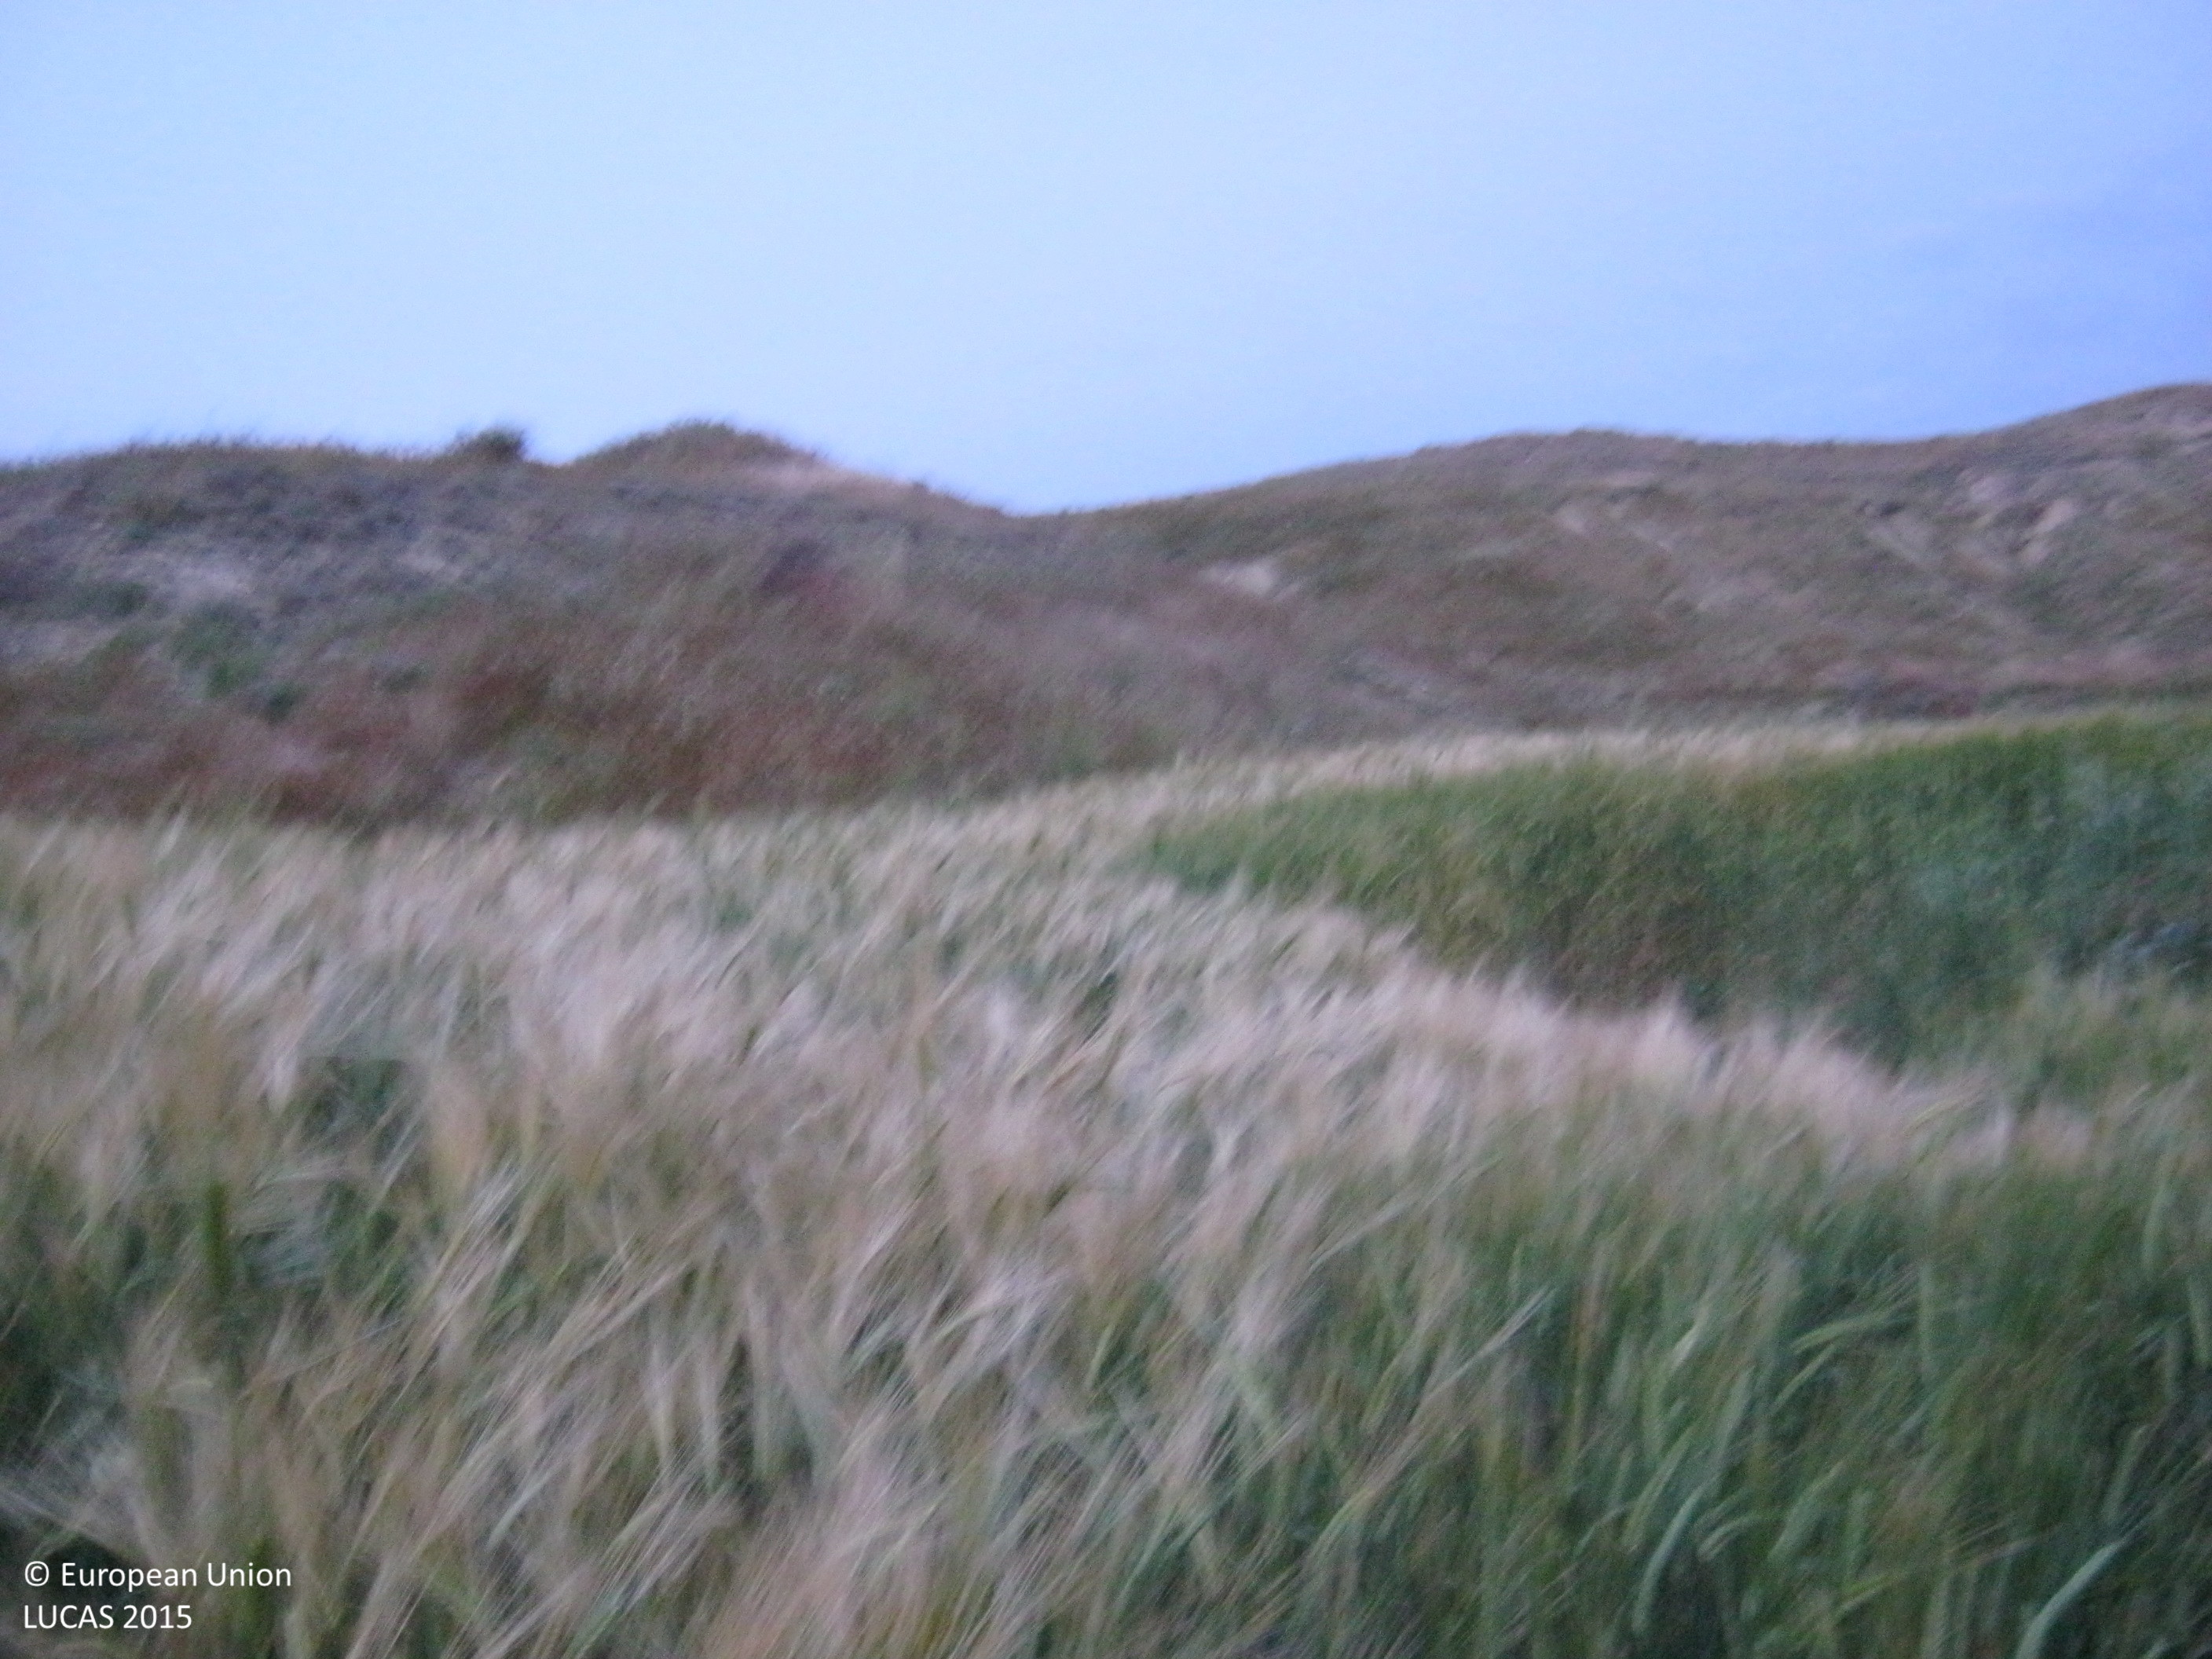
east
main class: Cropland
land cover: Common wheat
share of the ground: > 75 %
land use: Agriculture (excluding fallow land and kitchen gardens)
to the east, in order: Common wheat; Spontaneously vegetated surfaces; Common wheat; Spontaneously vegetated surfaces; Rocks and stones; Spontaneously vegetated surfaces; Rocks and stones; Spontaneously vegetated surfaces
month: April
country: CY
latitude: 35.0355
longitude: 33.3735
